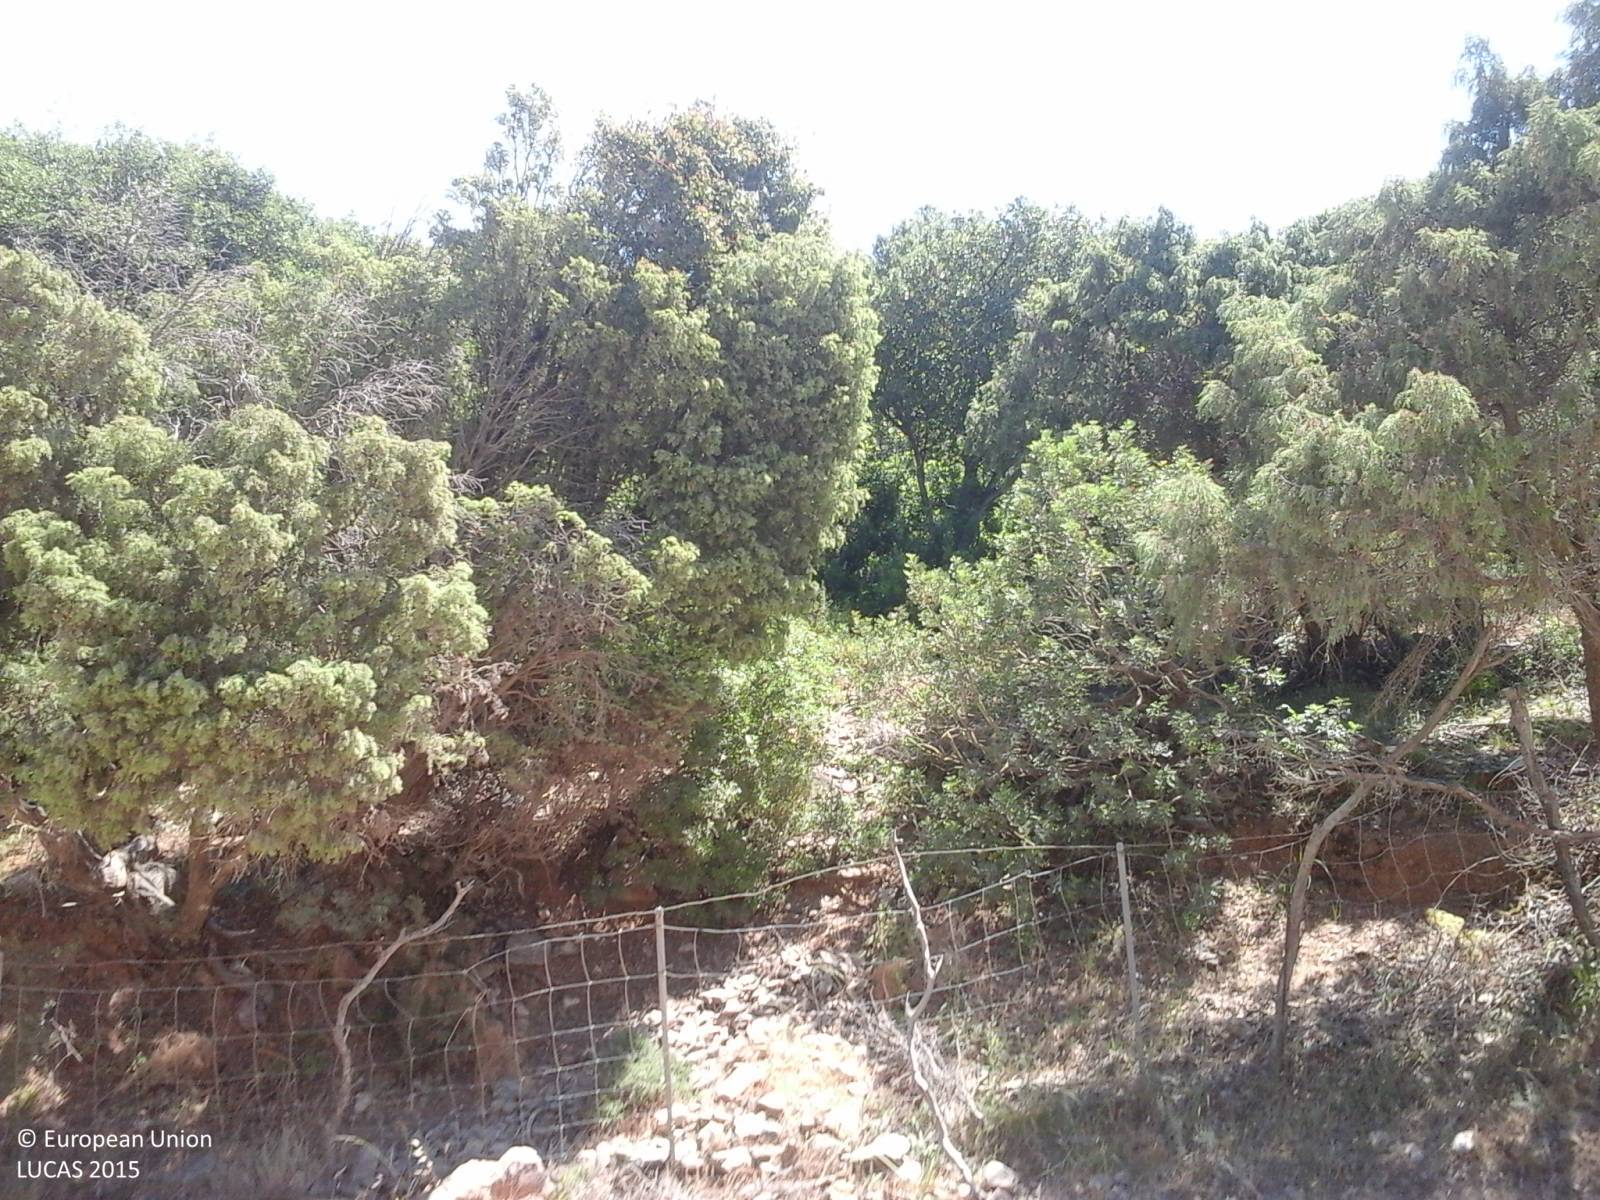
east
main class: Woodland
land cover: Broadleaved woodland
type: broadleaved evergreen forest
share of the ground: > 75 %
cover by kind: broadleaved forest trees 50 %, shrubs 30 %, coniferous forest trees 10 %, herbaceous plants 10 %
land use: Agriculture (excluding fallow land and kitchen gardens)
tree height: > 5 m
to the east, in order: Broadleaved woodland; Grassland with sparse tree/shrub cover; Shrubland with sparse tree cover; Tracks; Broadleaved woodland
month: June
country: IT
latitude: 38.9552
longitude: 8.7732
